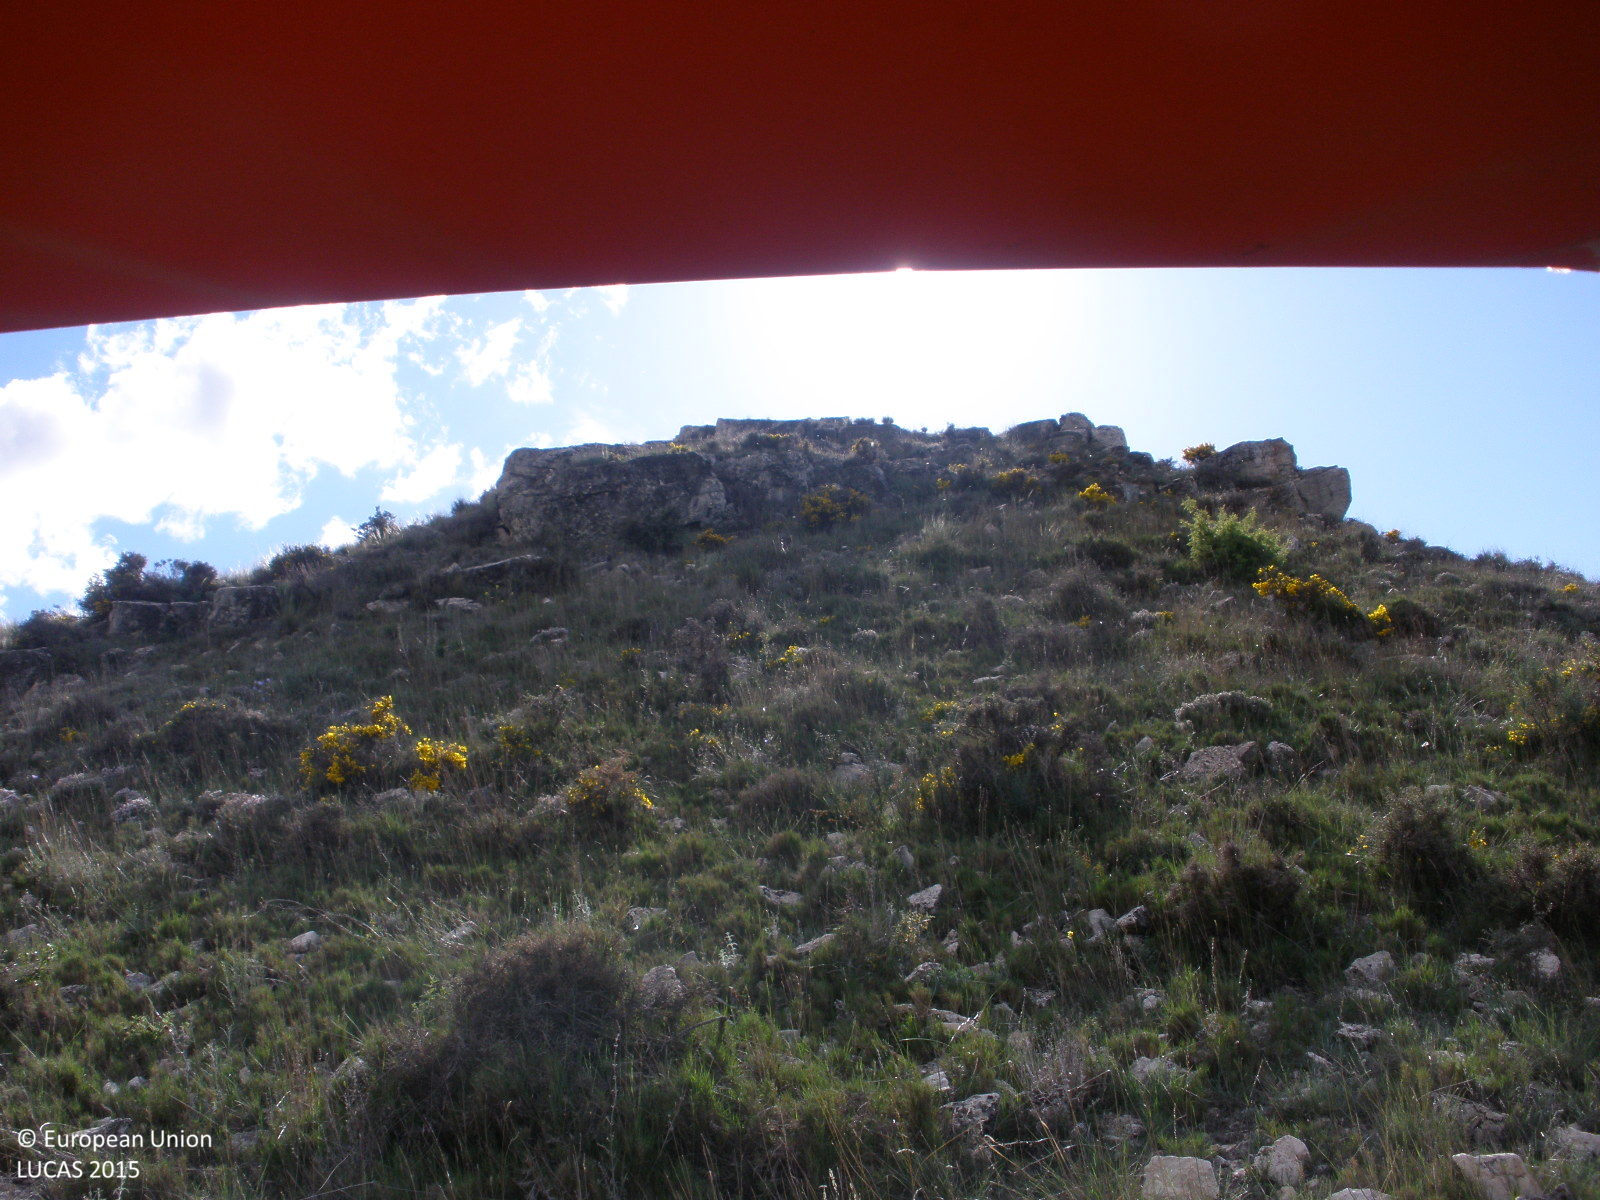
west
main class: Shrubland
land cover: Shrubland without tree cover
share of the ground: 50 - 75 %
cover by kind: shrubs 50 %, herbaceous plants 50 %
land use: Semi-natural and natural areas not in use
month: May
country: ES
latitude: 41.0590
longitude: -0.9280
